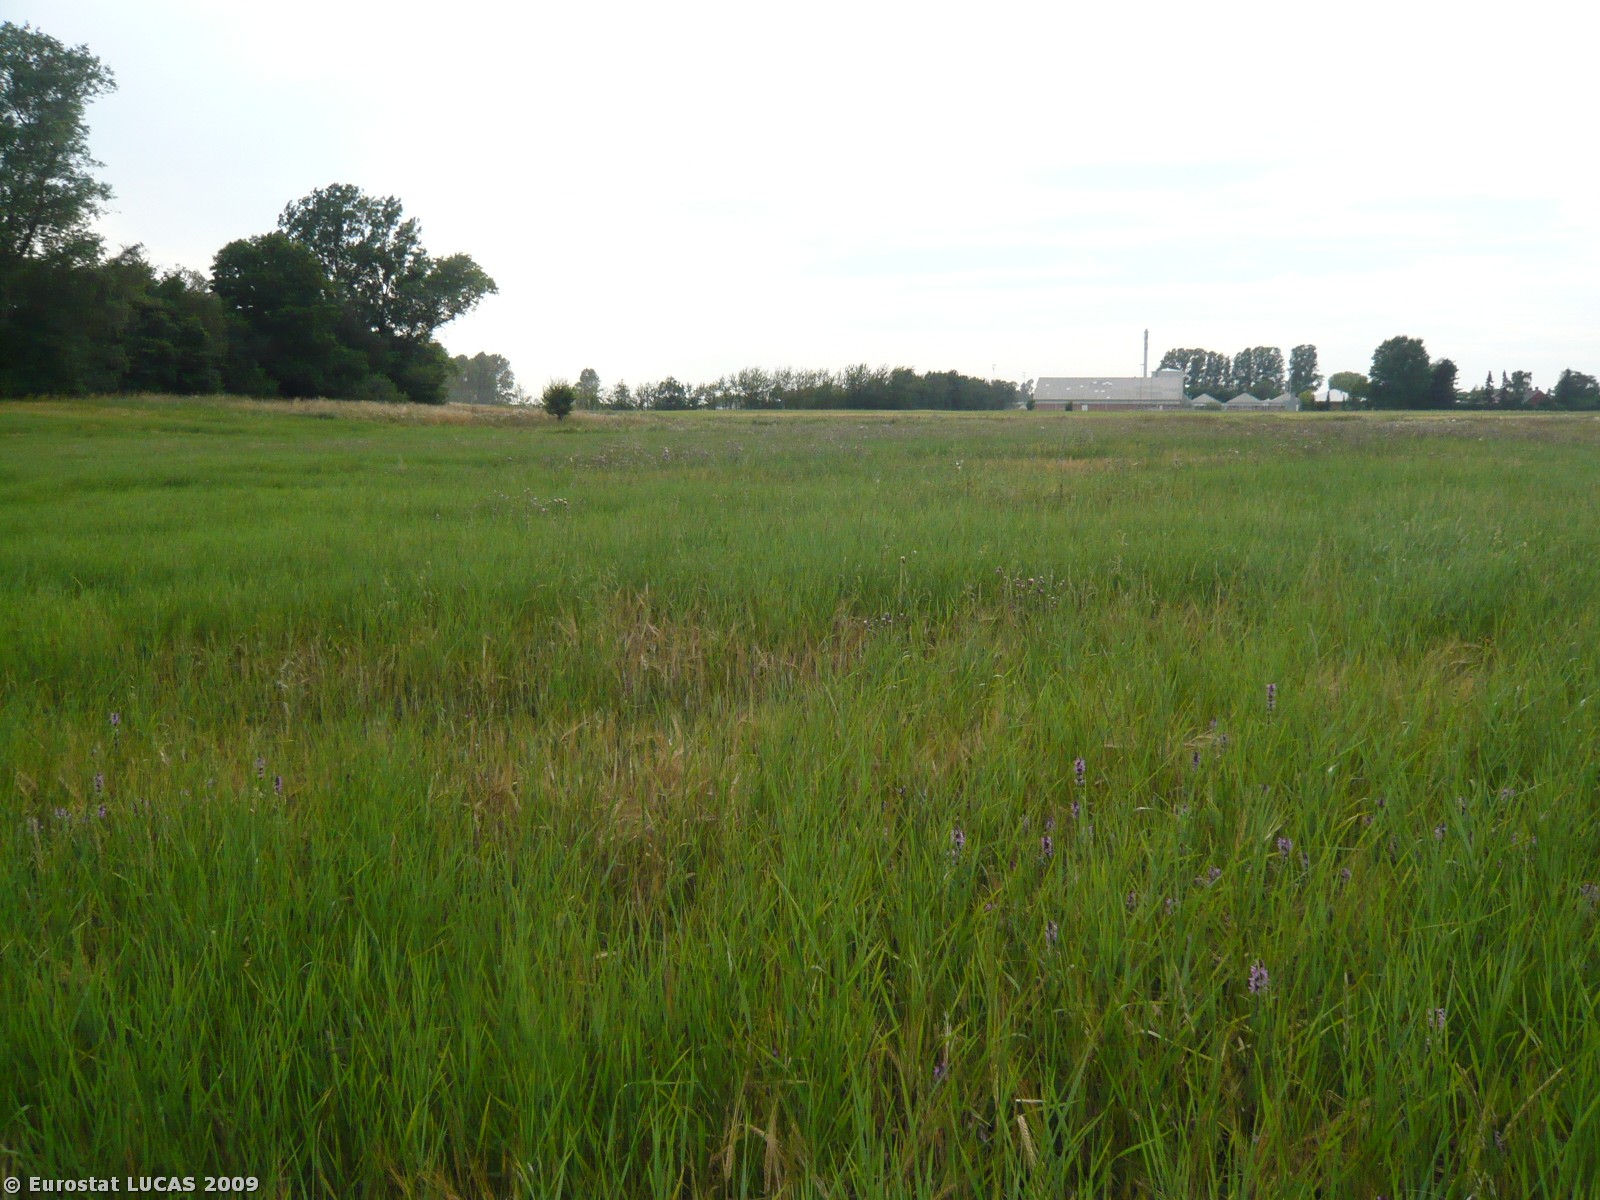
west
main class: Grassland
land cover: Spontaneously vegetated surfaces
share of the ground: > 75 %
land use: Fallow land
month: July
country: DK
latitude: 55.9358
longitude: 12.1591
